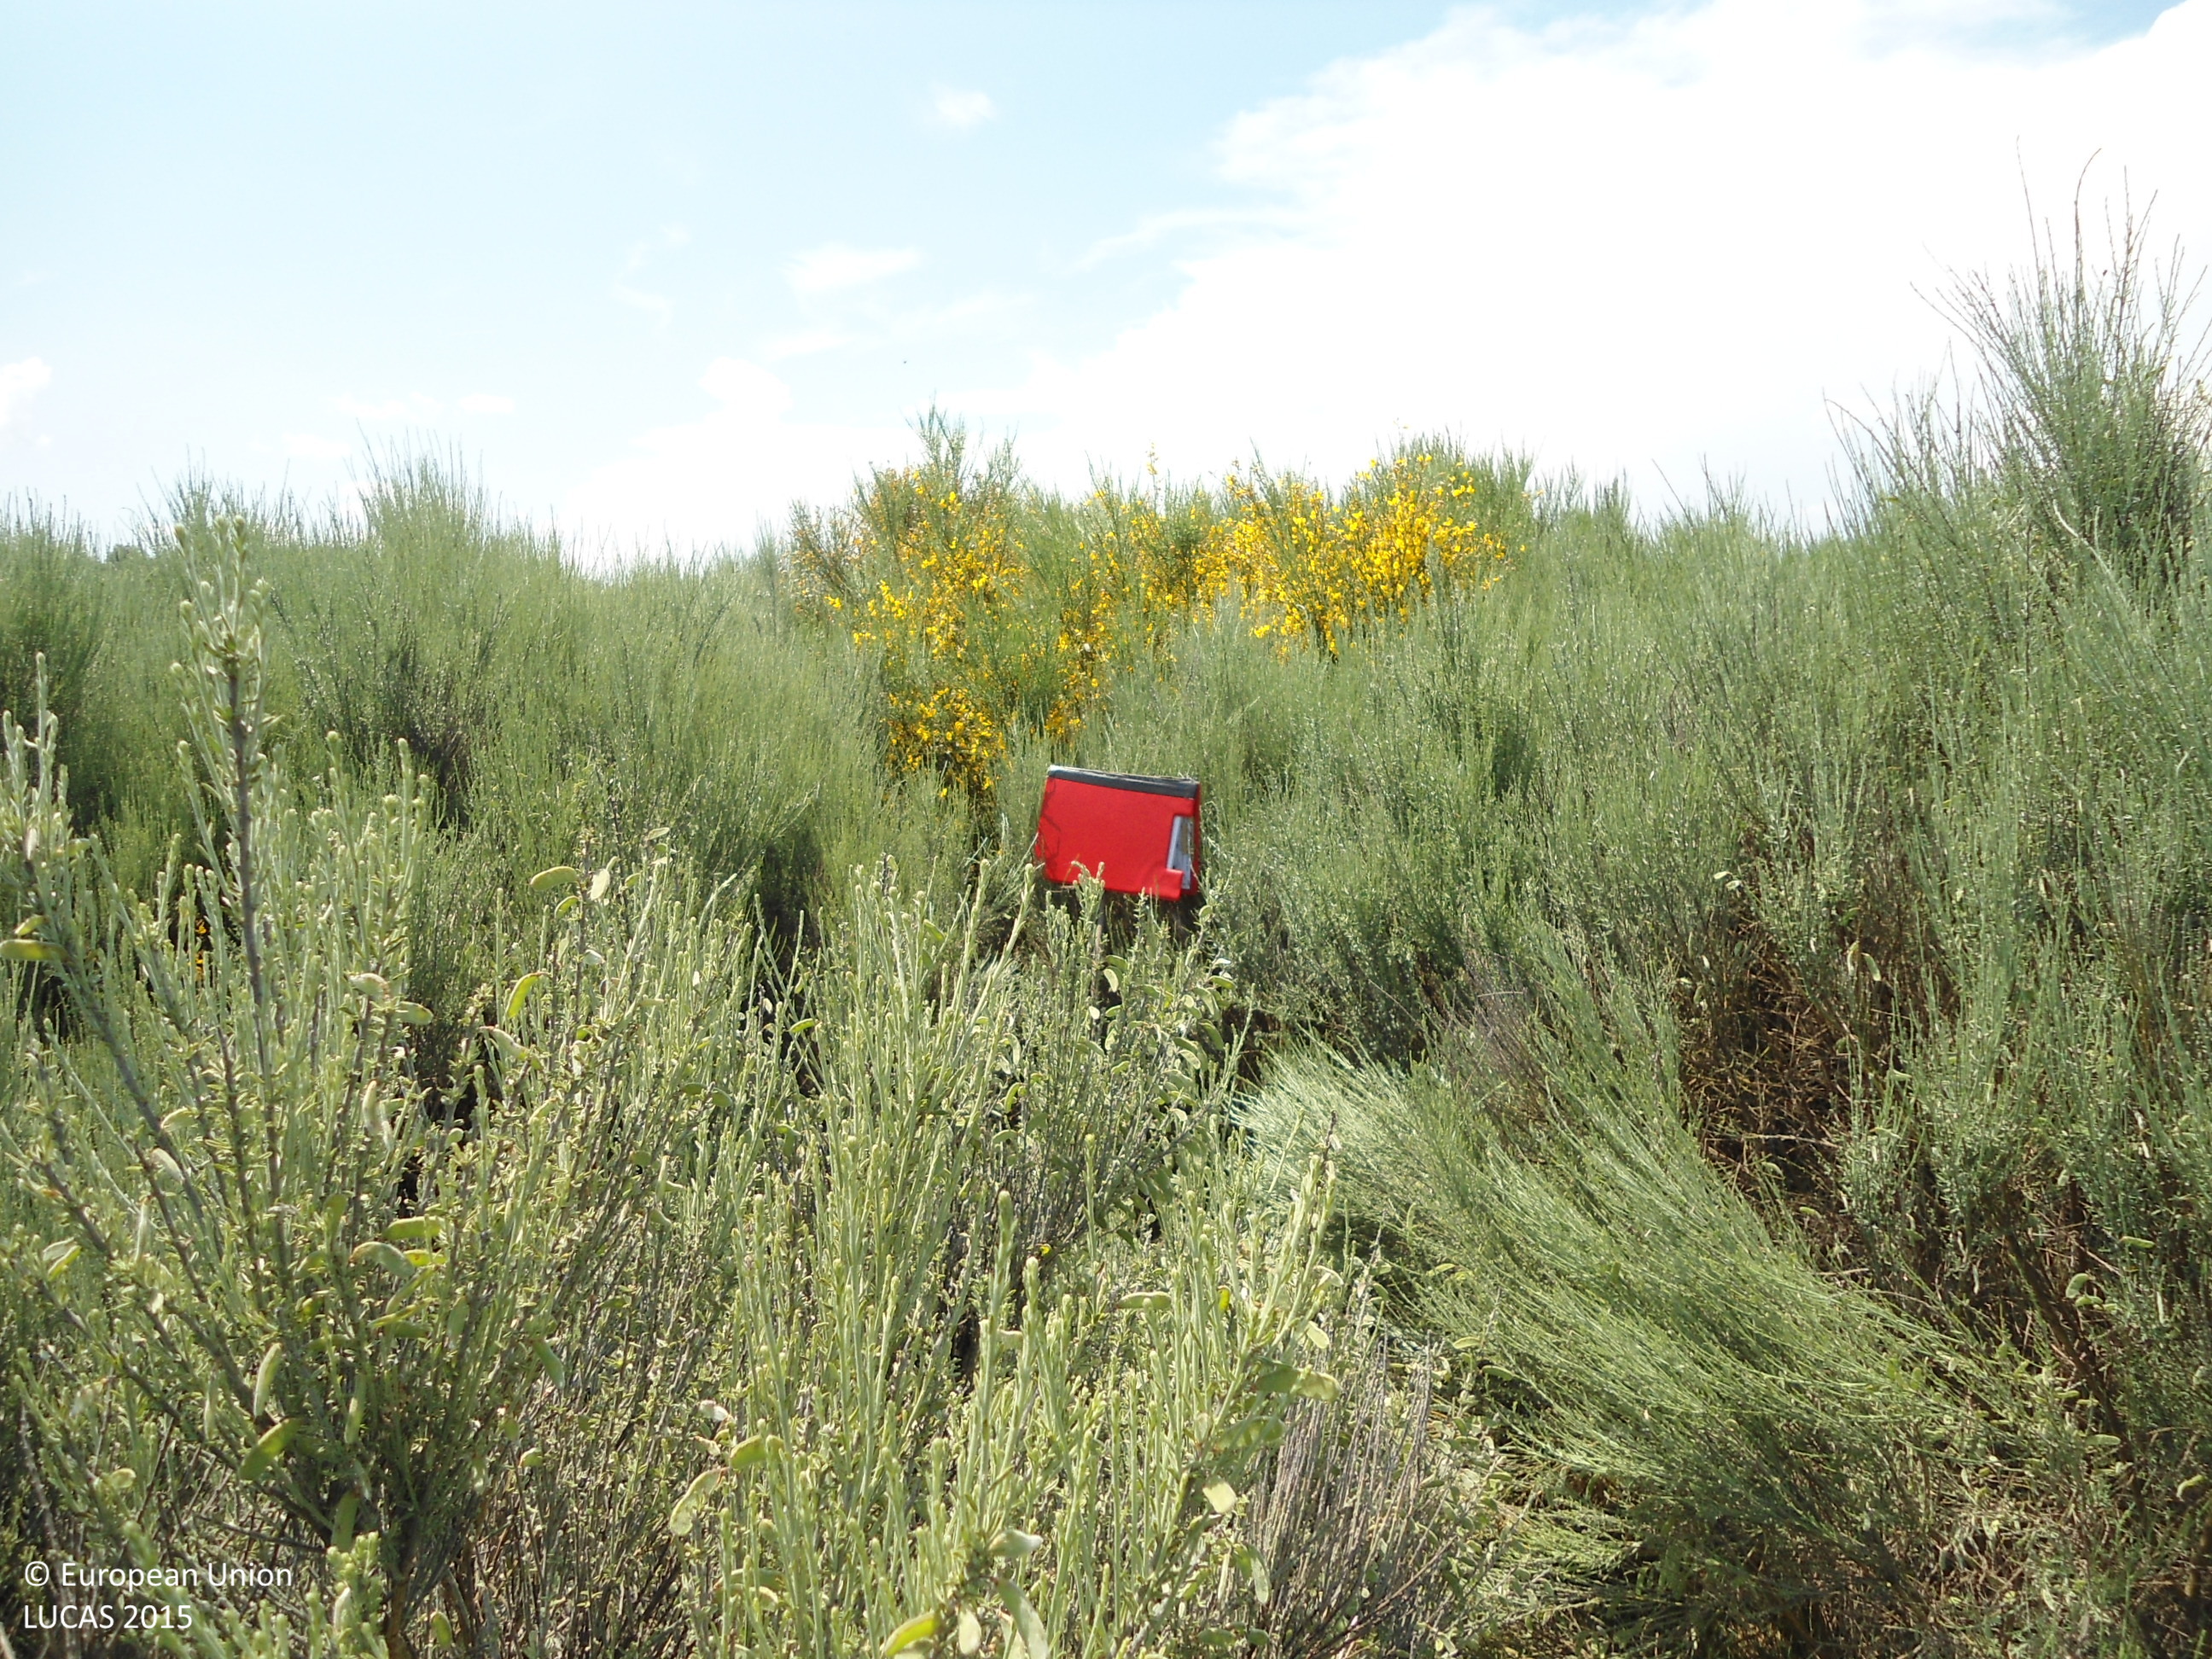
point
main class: Shrubland
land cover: Shrubland without tree cover
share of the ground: > 75 %
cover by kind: shrubs 95 %, herbaceous plants 5 %
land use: Semi-natural and natural areas not in use
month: June
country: ES
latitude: 41.9749
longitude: -6.3620
